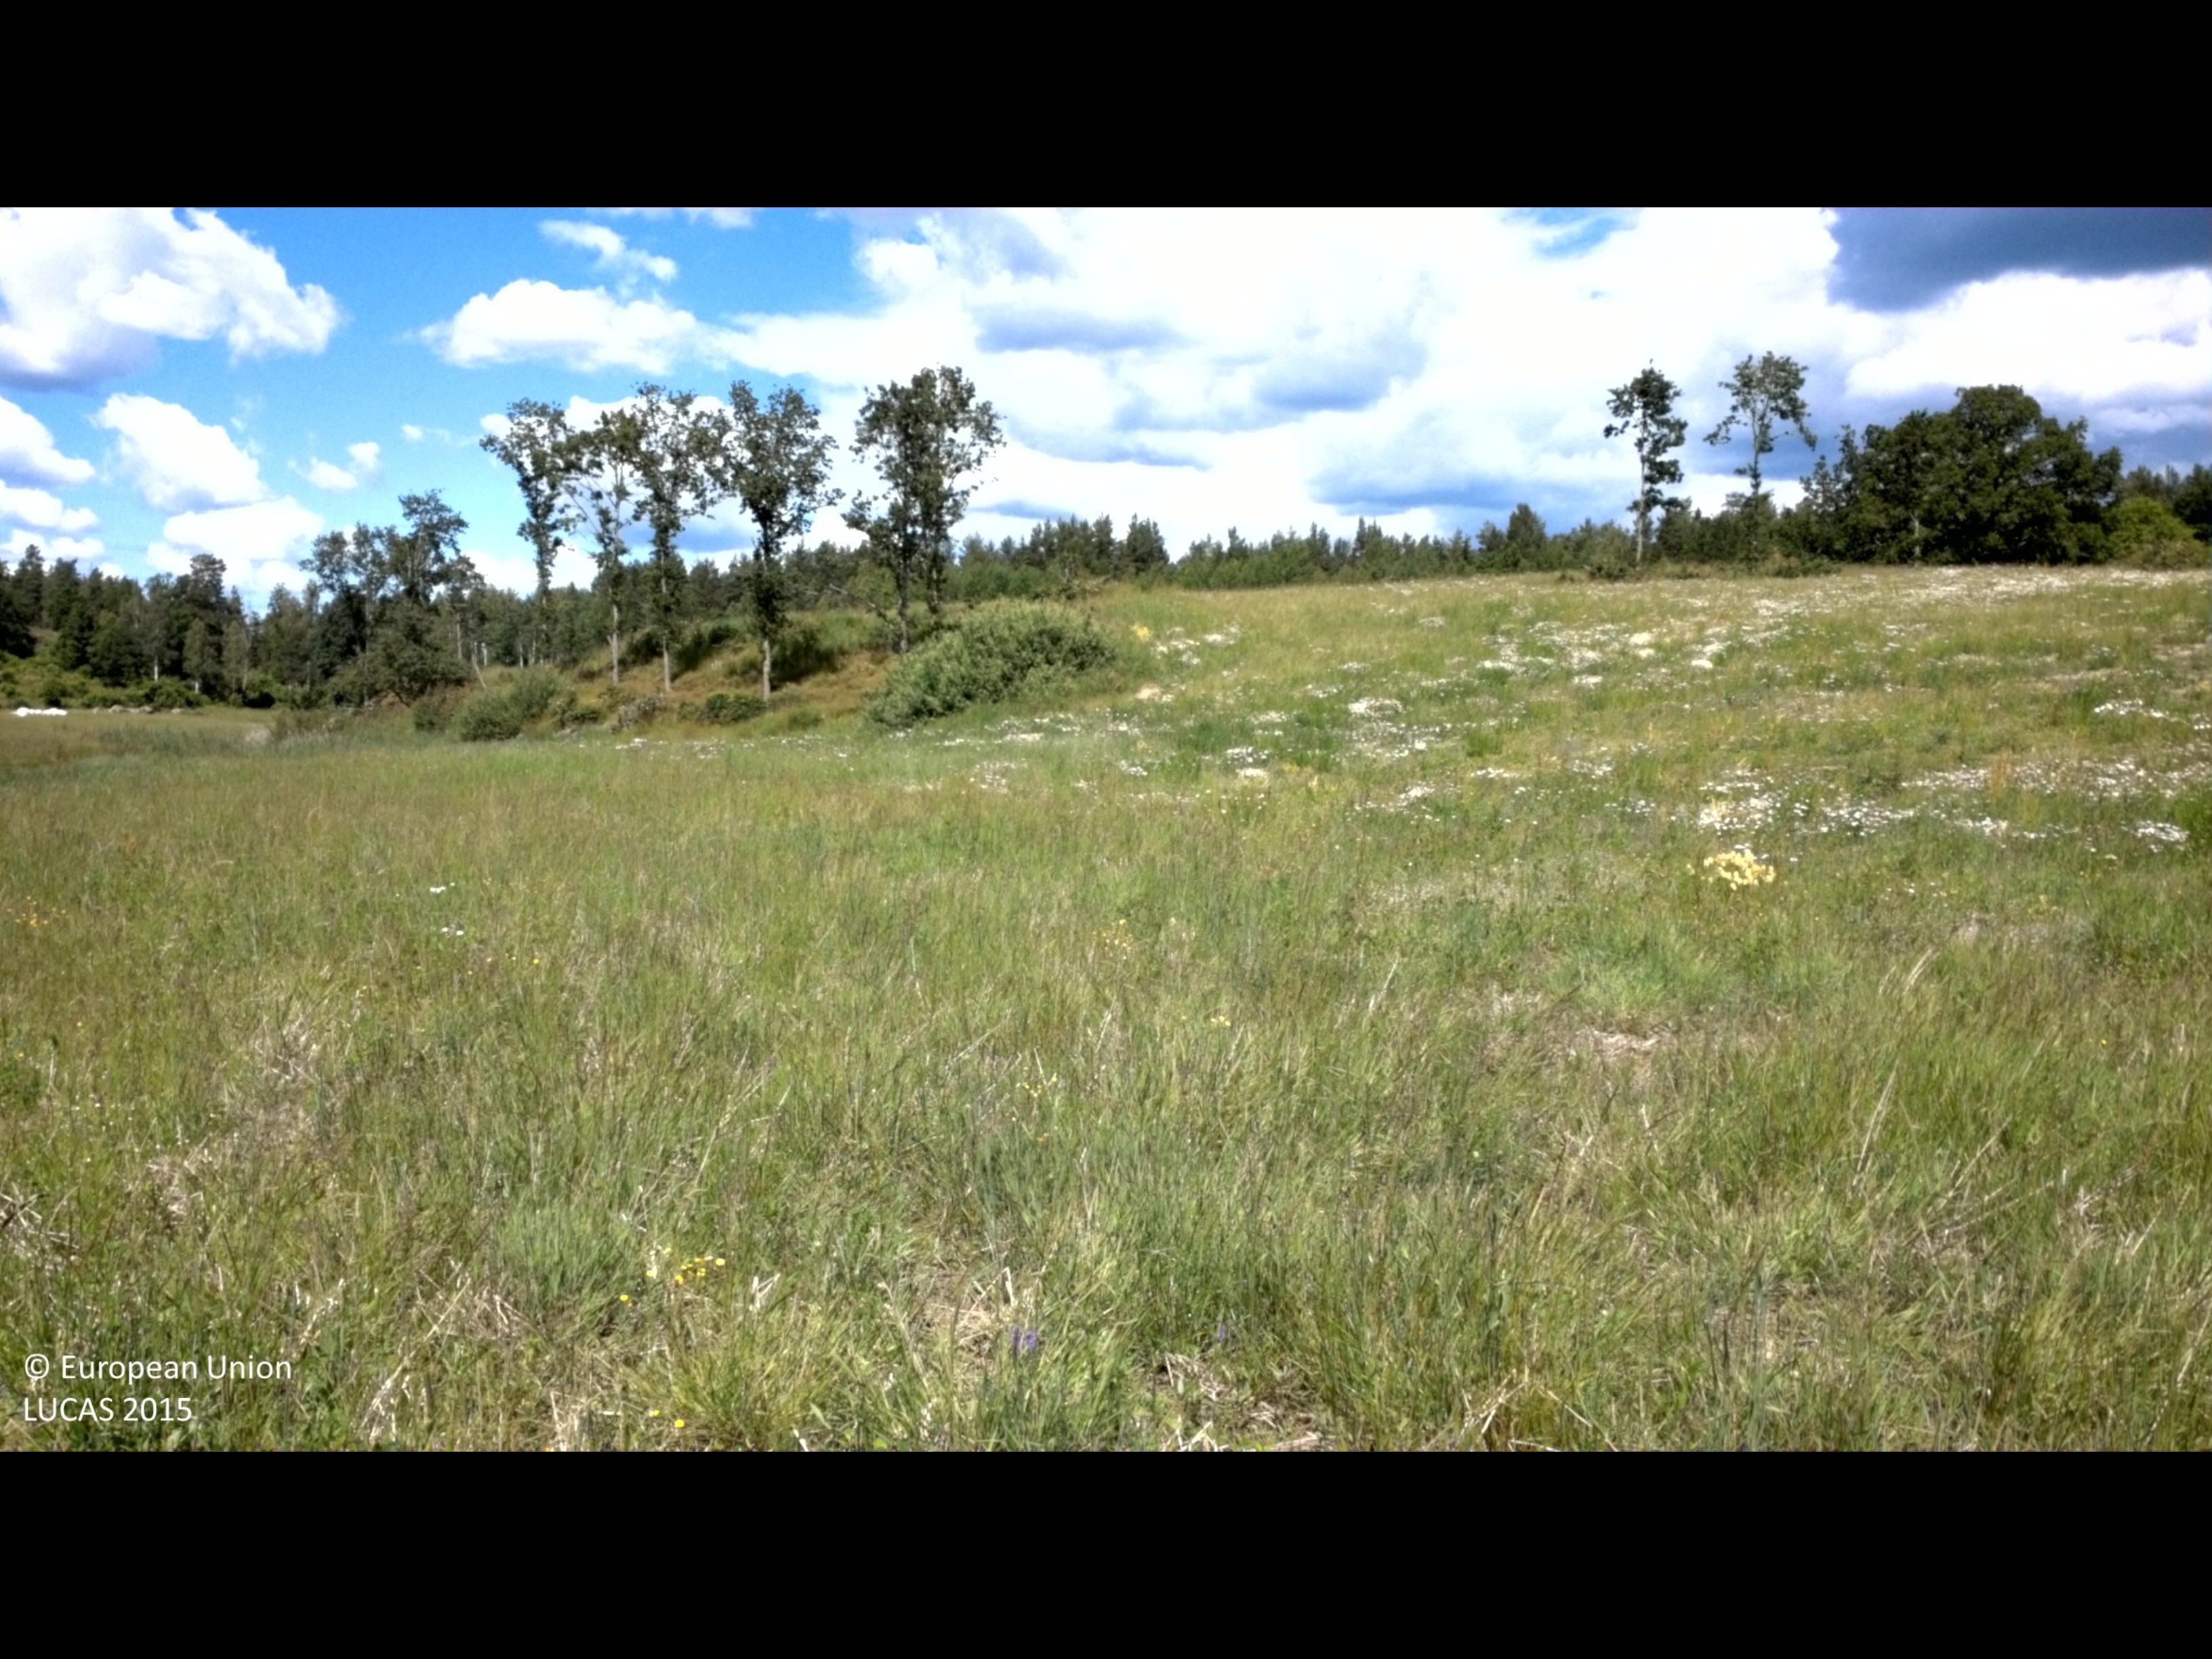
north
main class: Grassland
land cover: Spontaneously vegetated surfaces
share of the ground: > 75 %
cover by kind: herbaceous plants 90 %, unconsolidated bare surface 10 %
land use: Fallow land
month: July
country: SE
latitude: 58.2499
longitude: 16.3518
